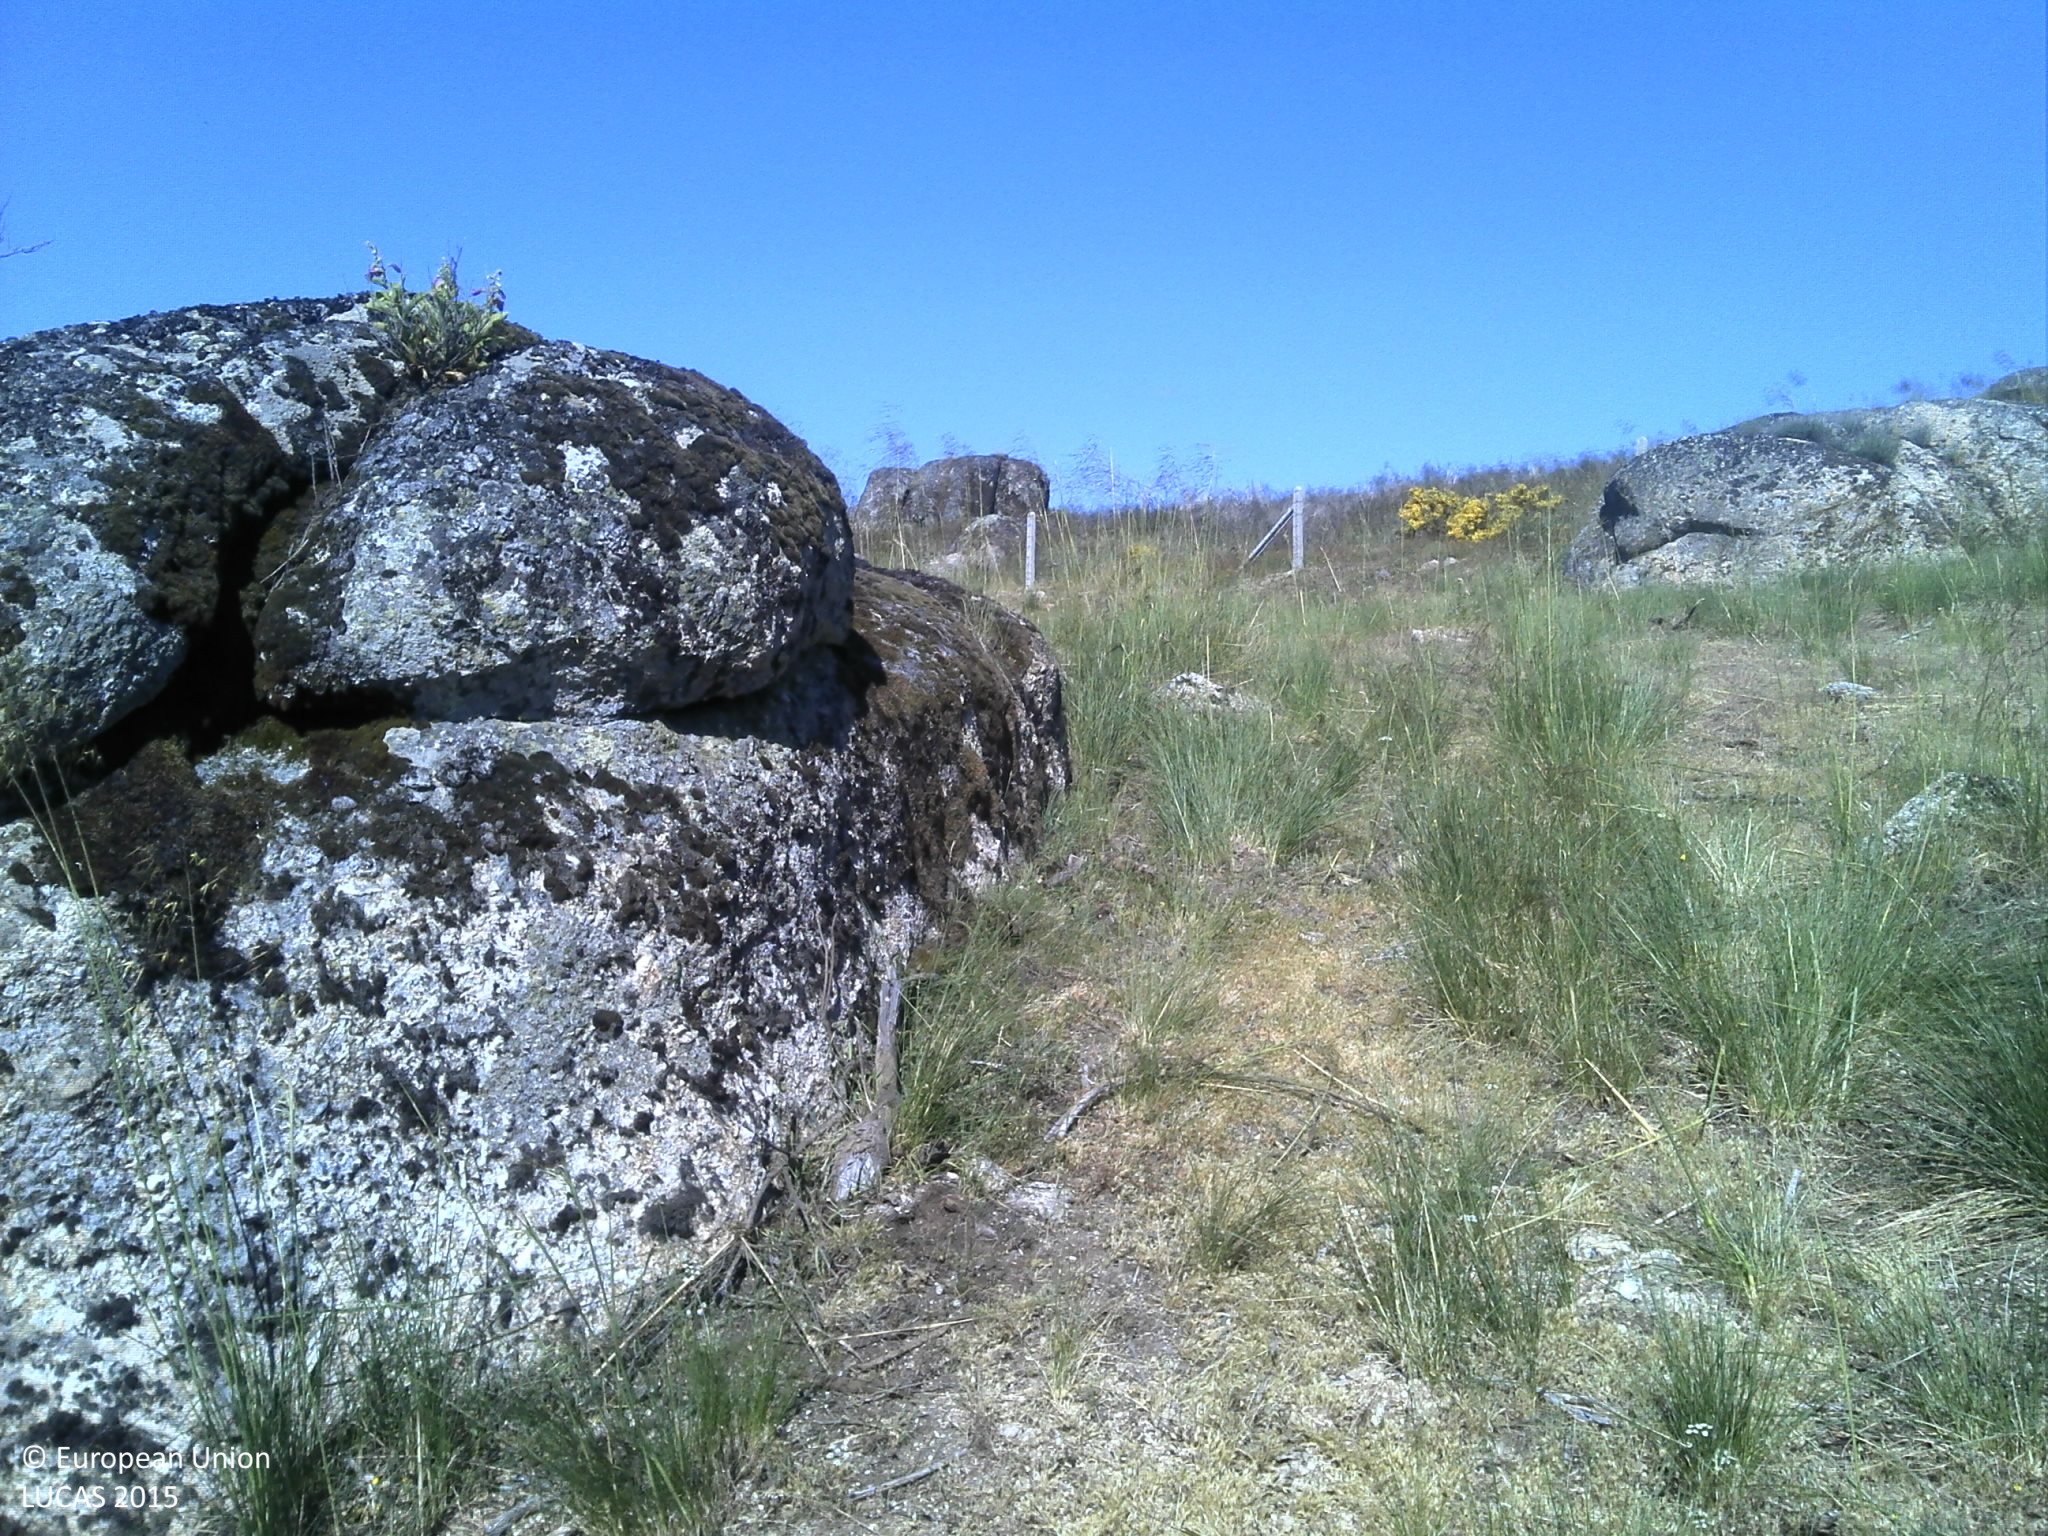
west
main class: Grassland
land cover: Grassland without tree/shrub cover
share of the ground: 10 - 25 %
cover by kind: unconsolidated bare surface 65 %, herbaceous plants 25 %, shrubs 5 %
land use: Agriculture (excluding fallow land and kitchen gardens)
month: May
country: PT
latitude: 40.5459
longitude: -7.2869
